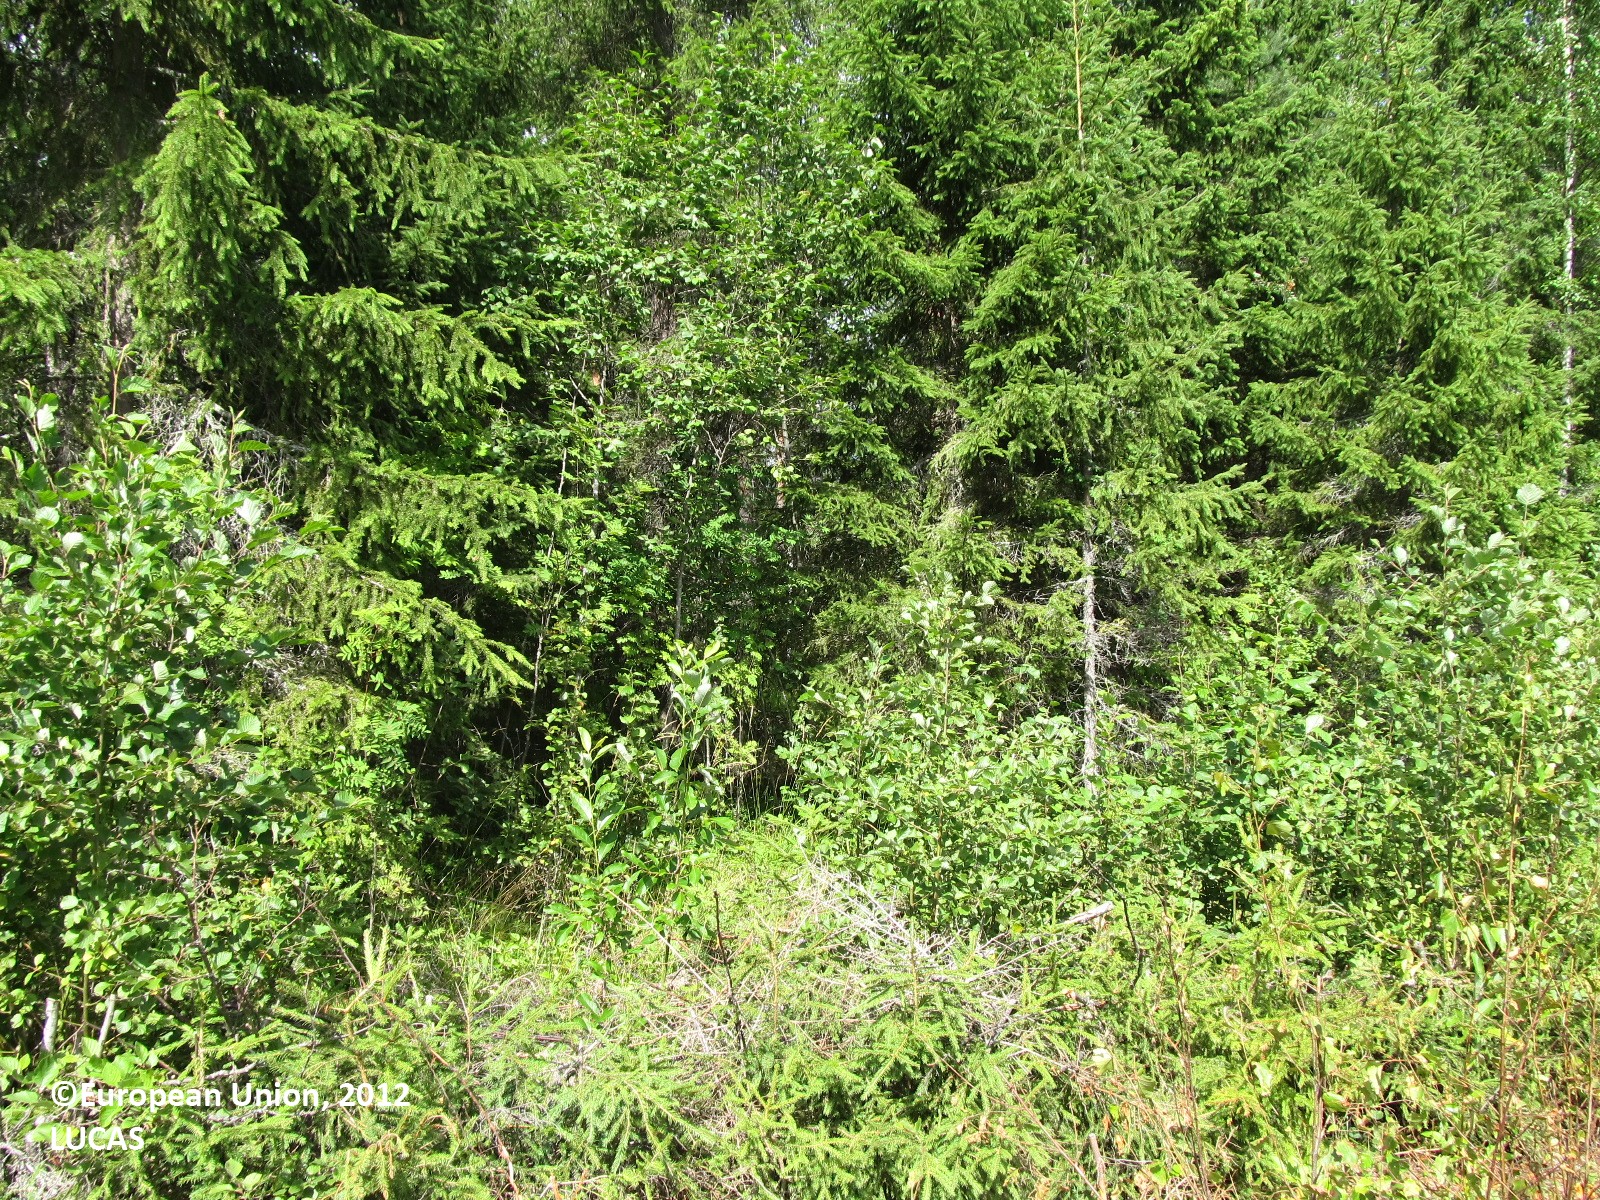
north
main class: Woodland
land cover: Pine dominated mixed woodland
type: boreal forest
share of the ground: 50 - 75 %
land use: Forestry
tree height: < 5 m
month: August
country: FI
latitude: 61.6874
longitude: 27.9378
